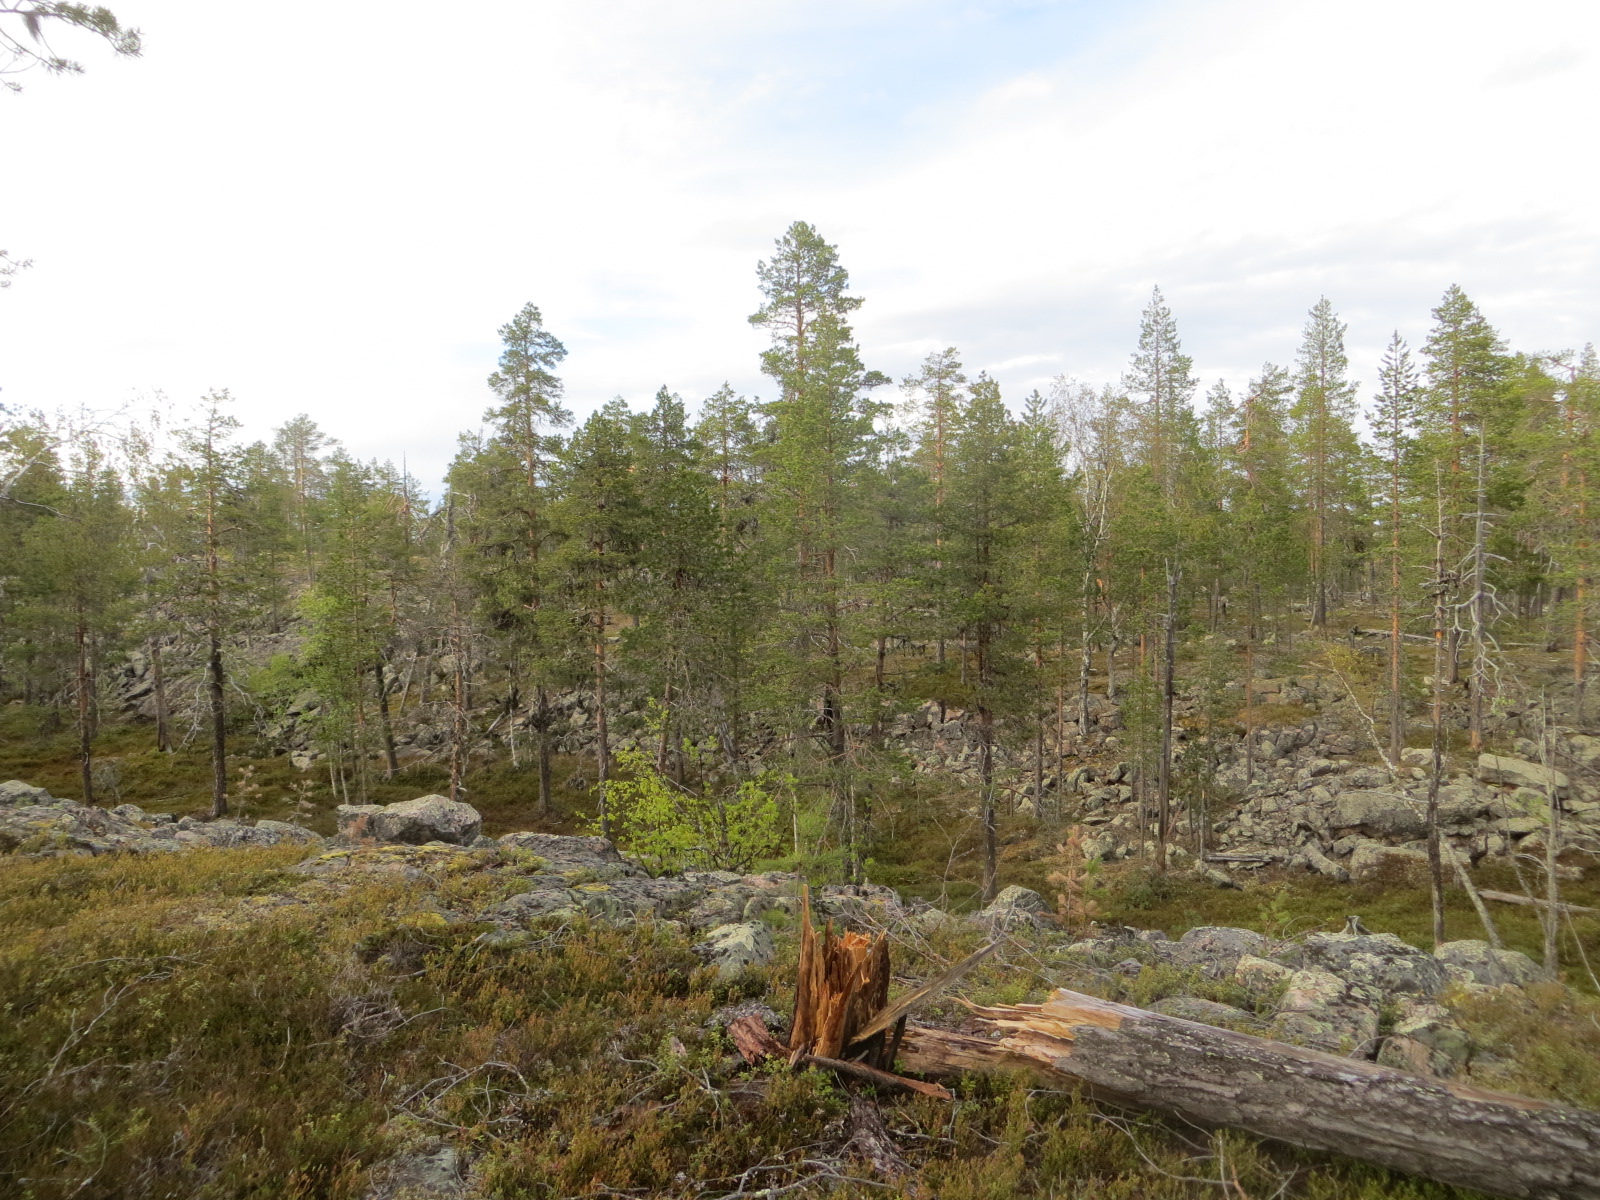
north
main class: Woodland
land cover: Pine dominated coniferous woodland
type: boreal forest
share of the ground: 50 - 75 %
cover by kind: coniferous forest trees 50 %, shrubs 25 %, consolidated bare surface 25 %
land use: Forestry
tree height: > 5 m
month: June
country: FI
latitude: 67.4126
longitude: 25.6620
